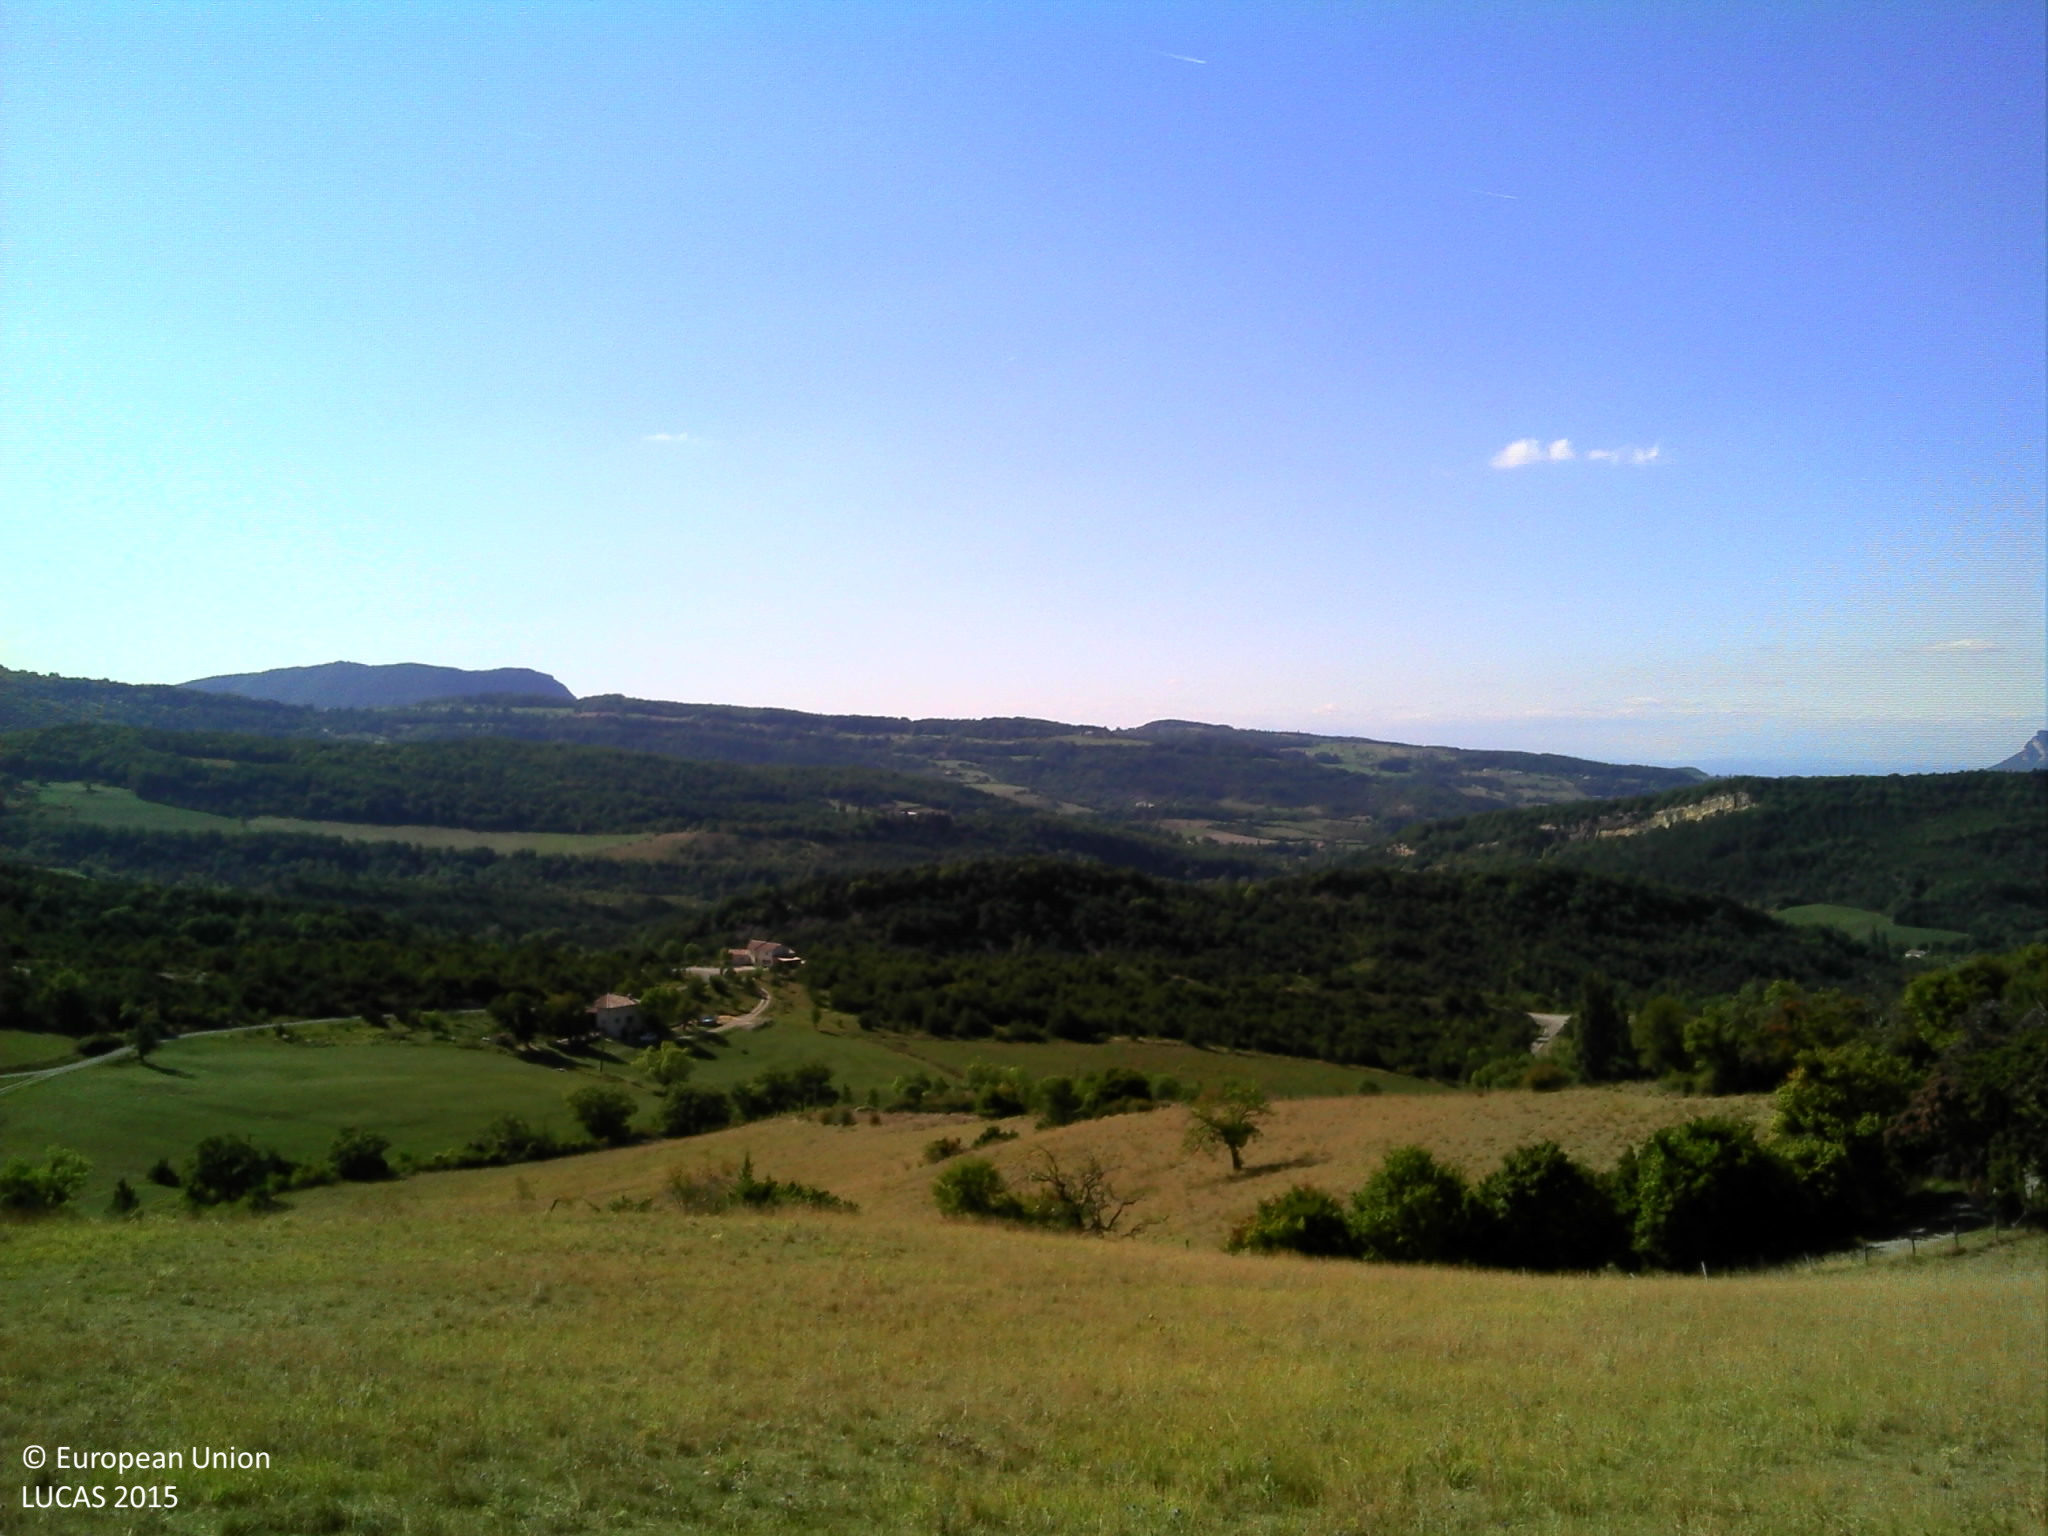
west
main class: Grassland
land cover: Grassland without tree/shrub cover
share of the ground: > 75 %
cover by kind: herbaceous plants 95 %, shrubs 5 %
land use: Agriculture (excluding fallow land and kitchen gardens)
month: September
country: FR
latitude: 44.5639
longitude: 5.1846
